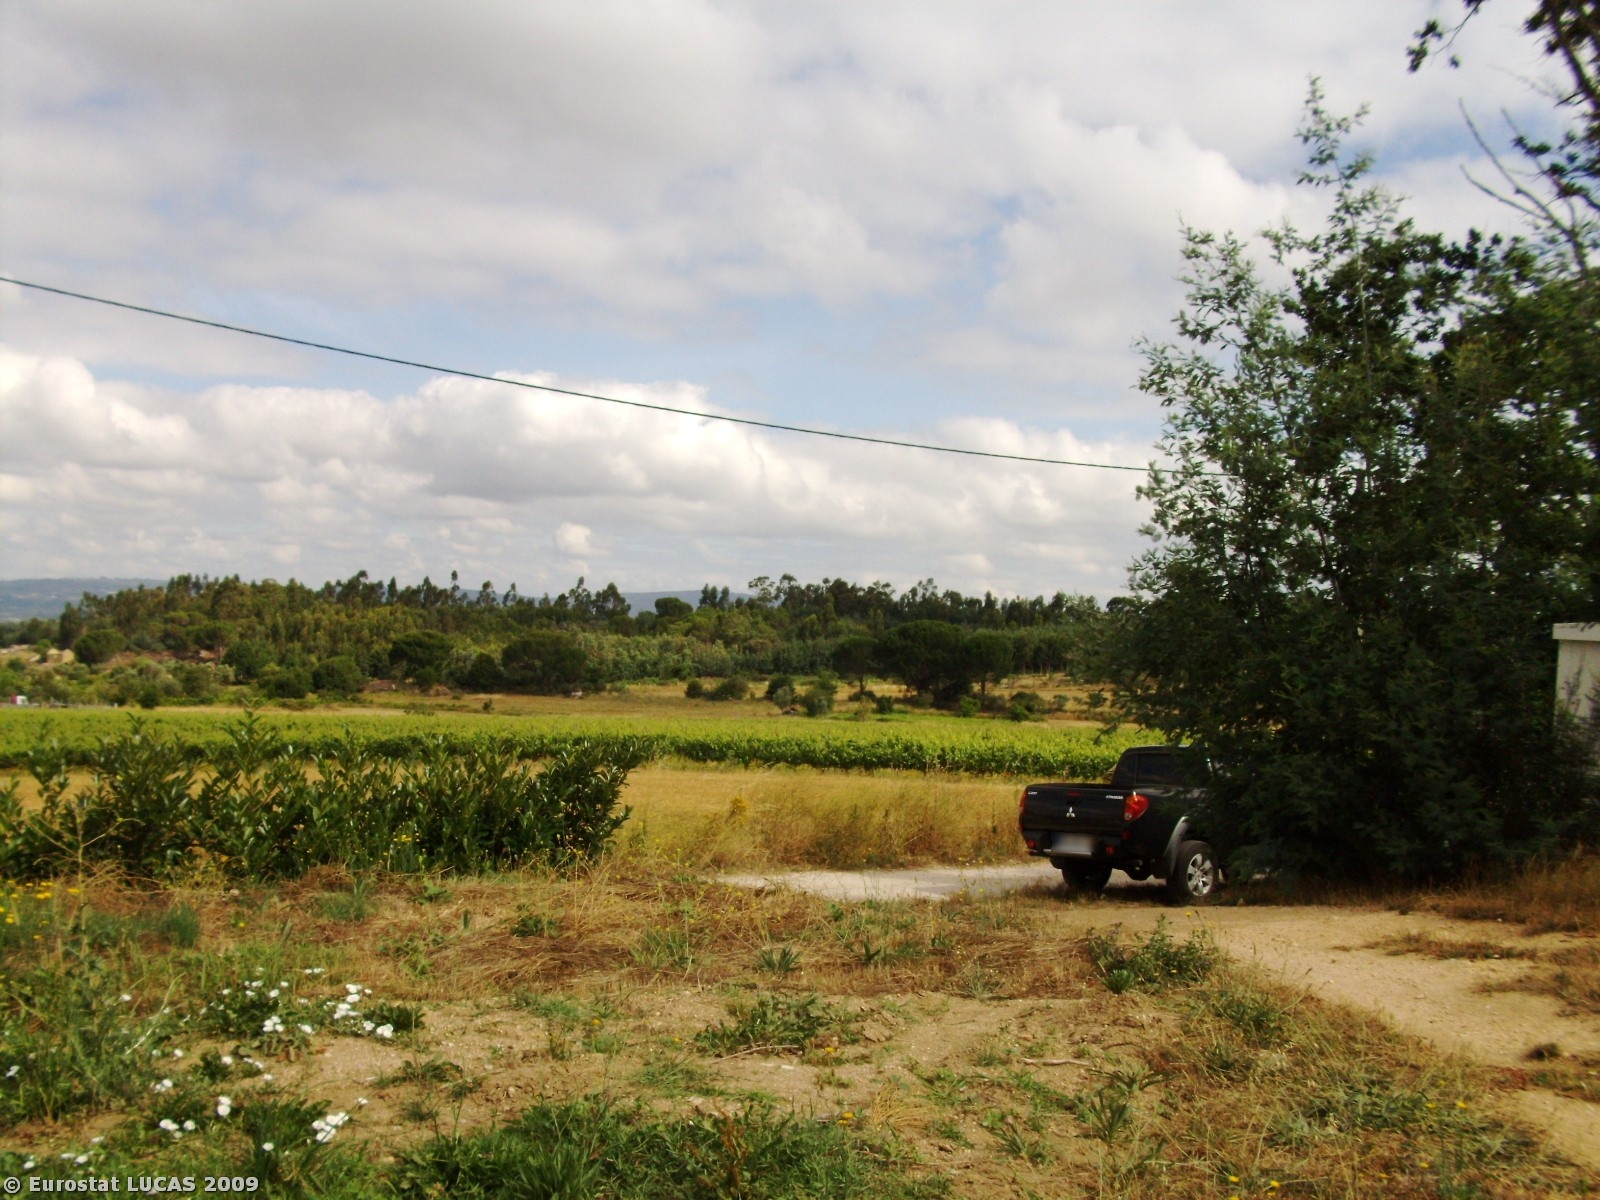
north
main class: Grassland
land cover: Spontaneously vegetated surfaces
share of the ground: > 75 %
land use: Fallow land
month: July
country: PT
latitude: 40.5055
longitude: -7.6145
